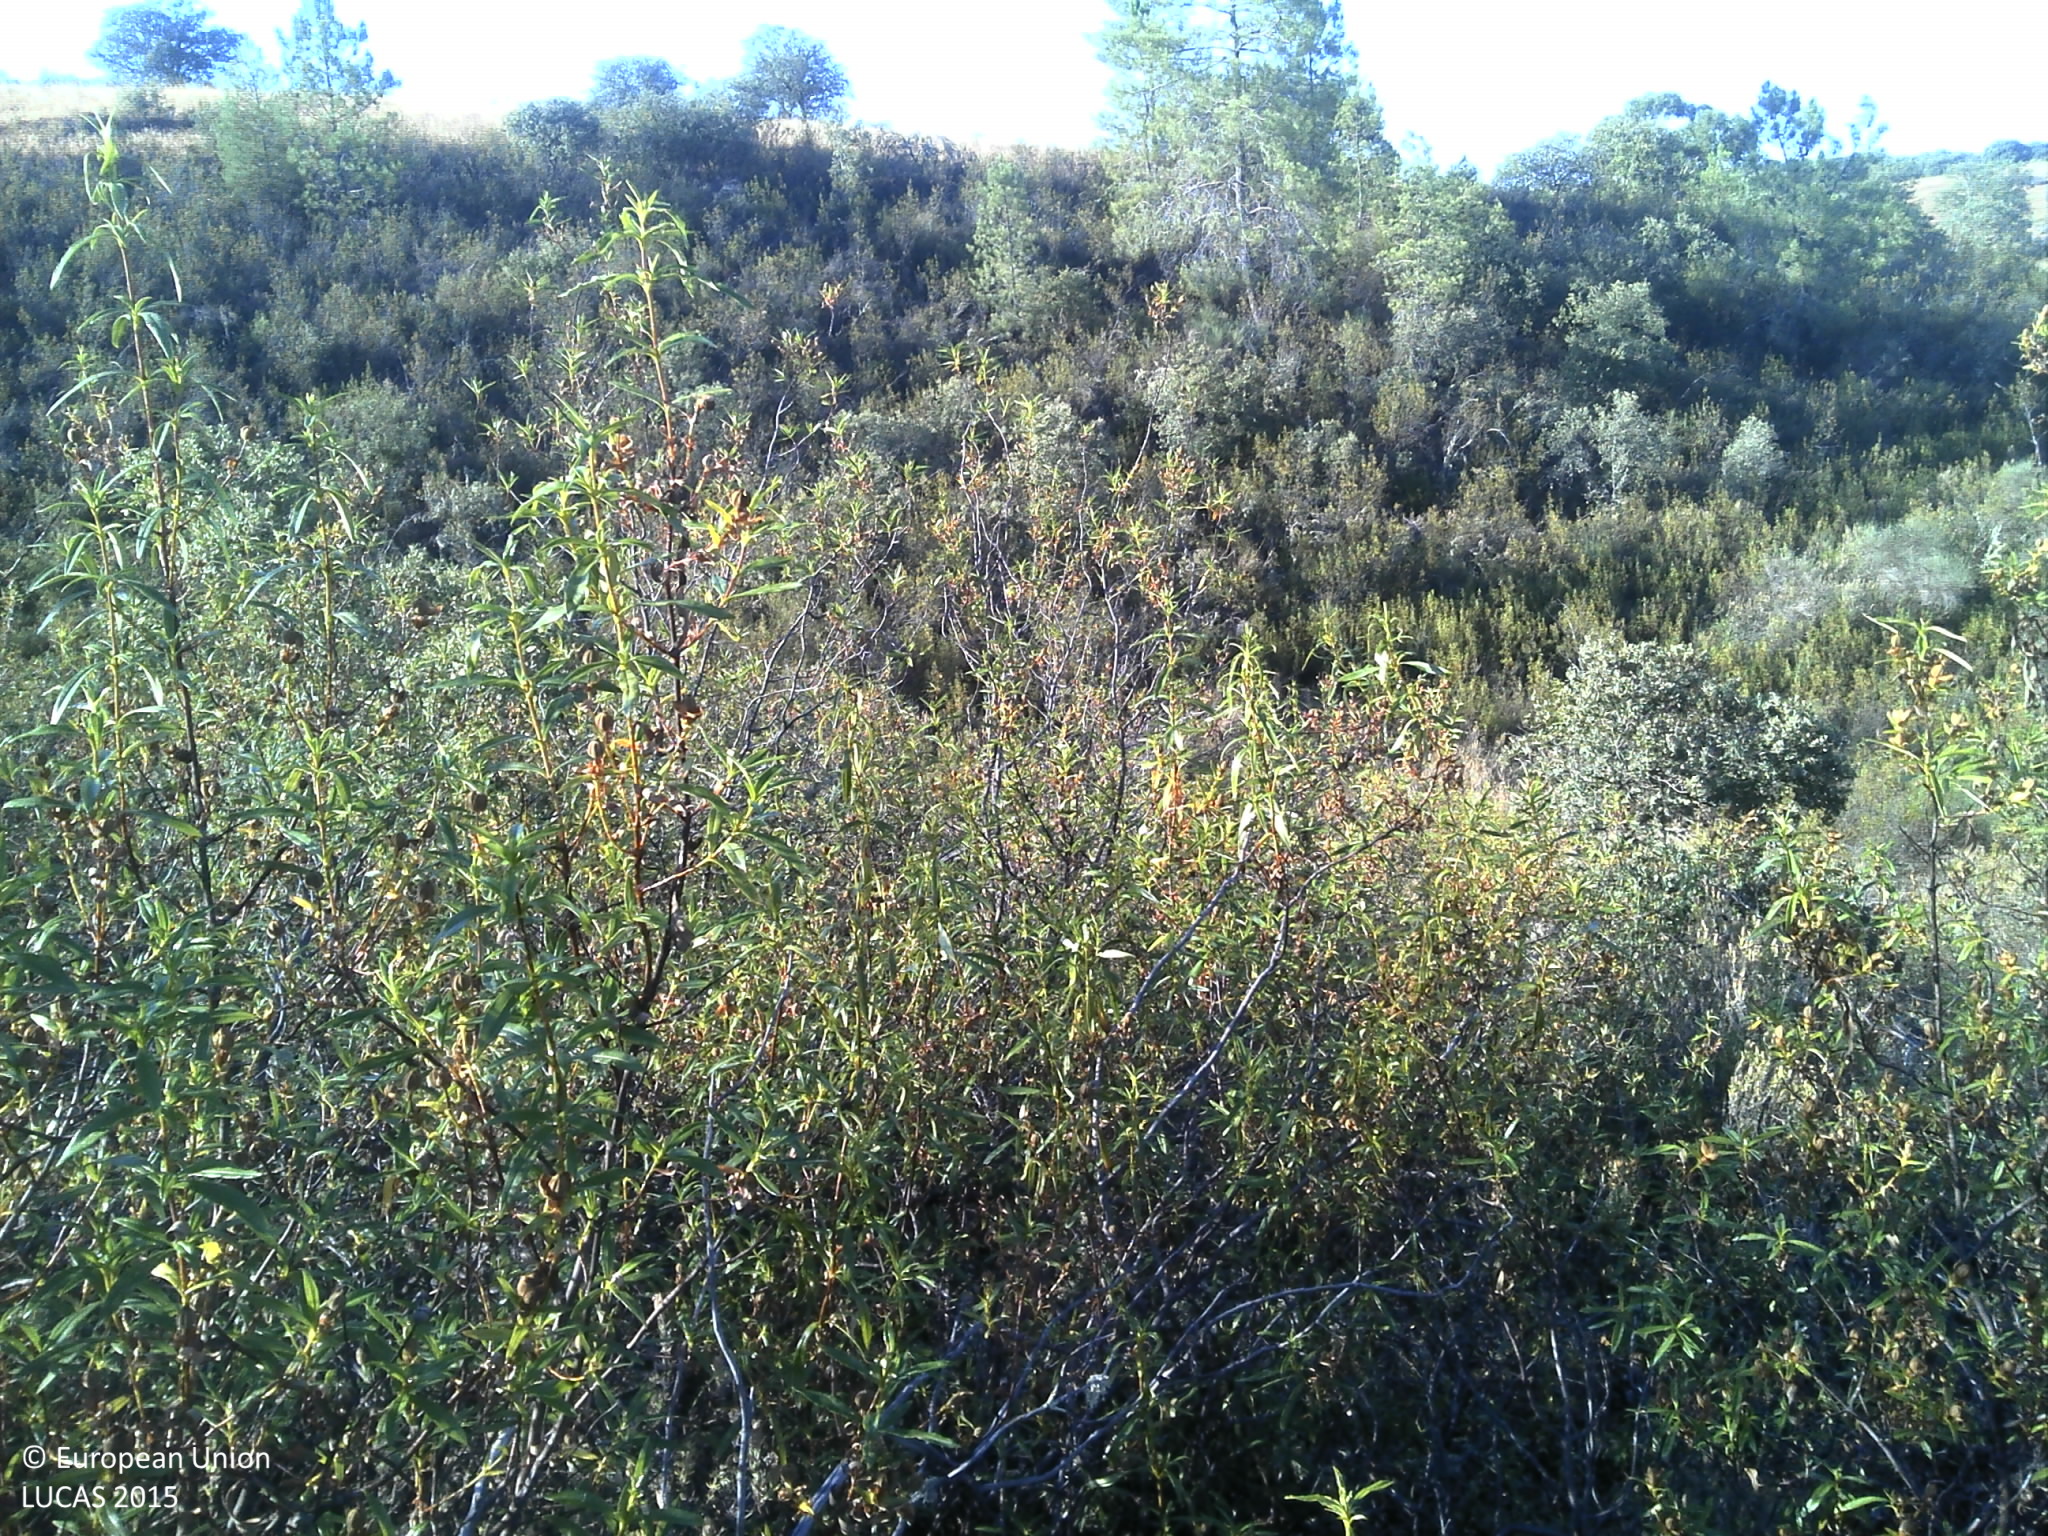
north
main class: Shrubland
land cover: Shrubland with sparse tree cover
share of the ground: 50 - 75 %
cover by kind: shrubs 75 %, herbaceous plants 10 %, coniferous forest trees 5 %, unconsolidated bare surface 5 %
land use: Forestry
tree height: > 5 m
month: June
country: PT
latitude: 39.9524
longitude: -7.0995
